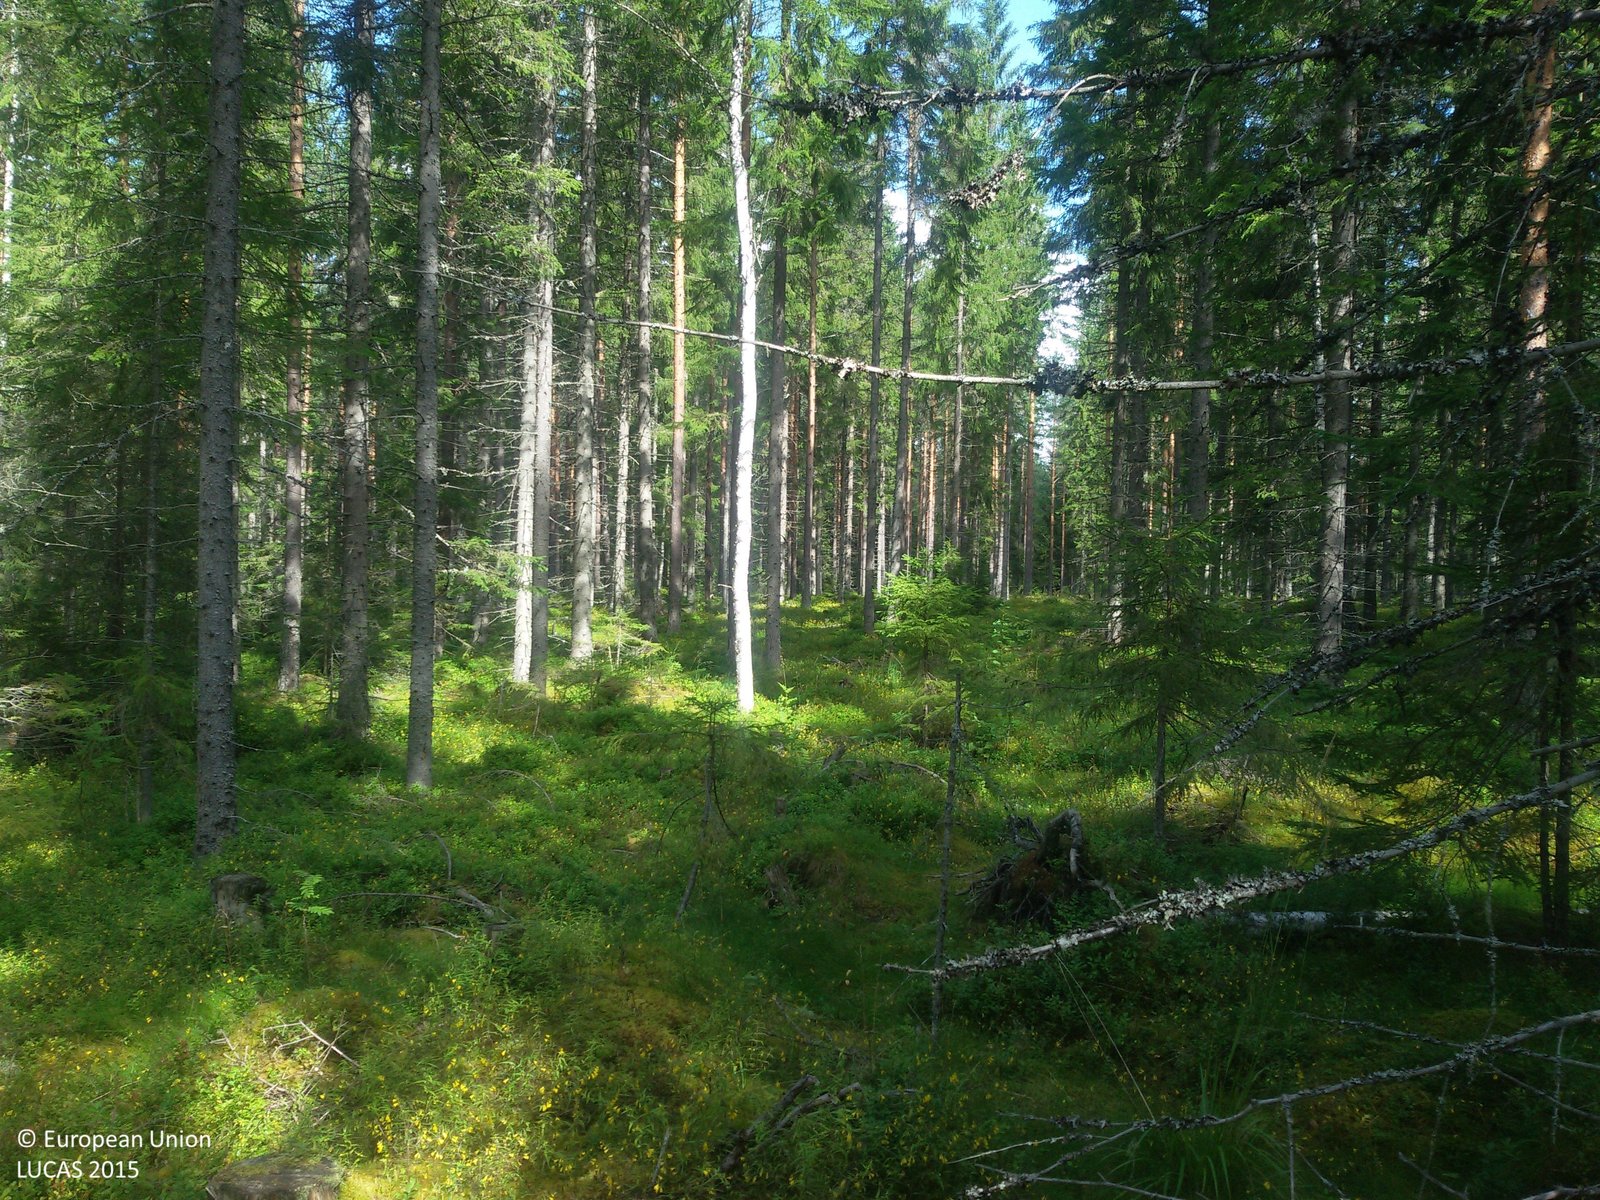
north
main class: Woodland
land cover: Spruce dominated coniferous woodland
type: boreal forest
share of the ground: 50 - 75 %
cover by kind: coniferous forest trees 70 %, herbaceous plants 15 %, lichens and mosses 15 %
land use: Forestry
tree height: > 5 m
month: August
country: SE
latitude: 60.7632
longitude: 16.6871
